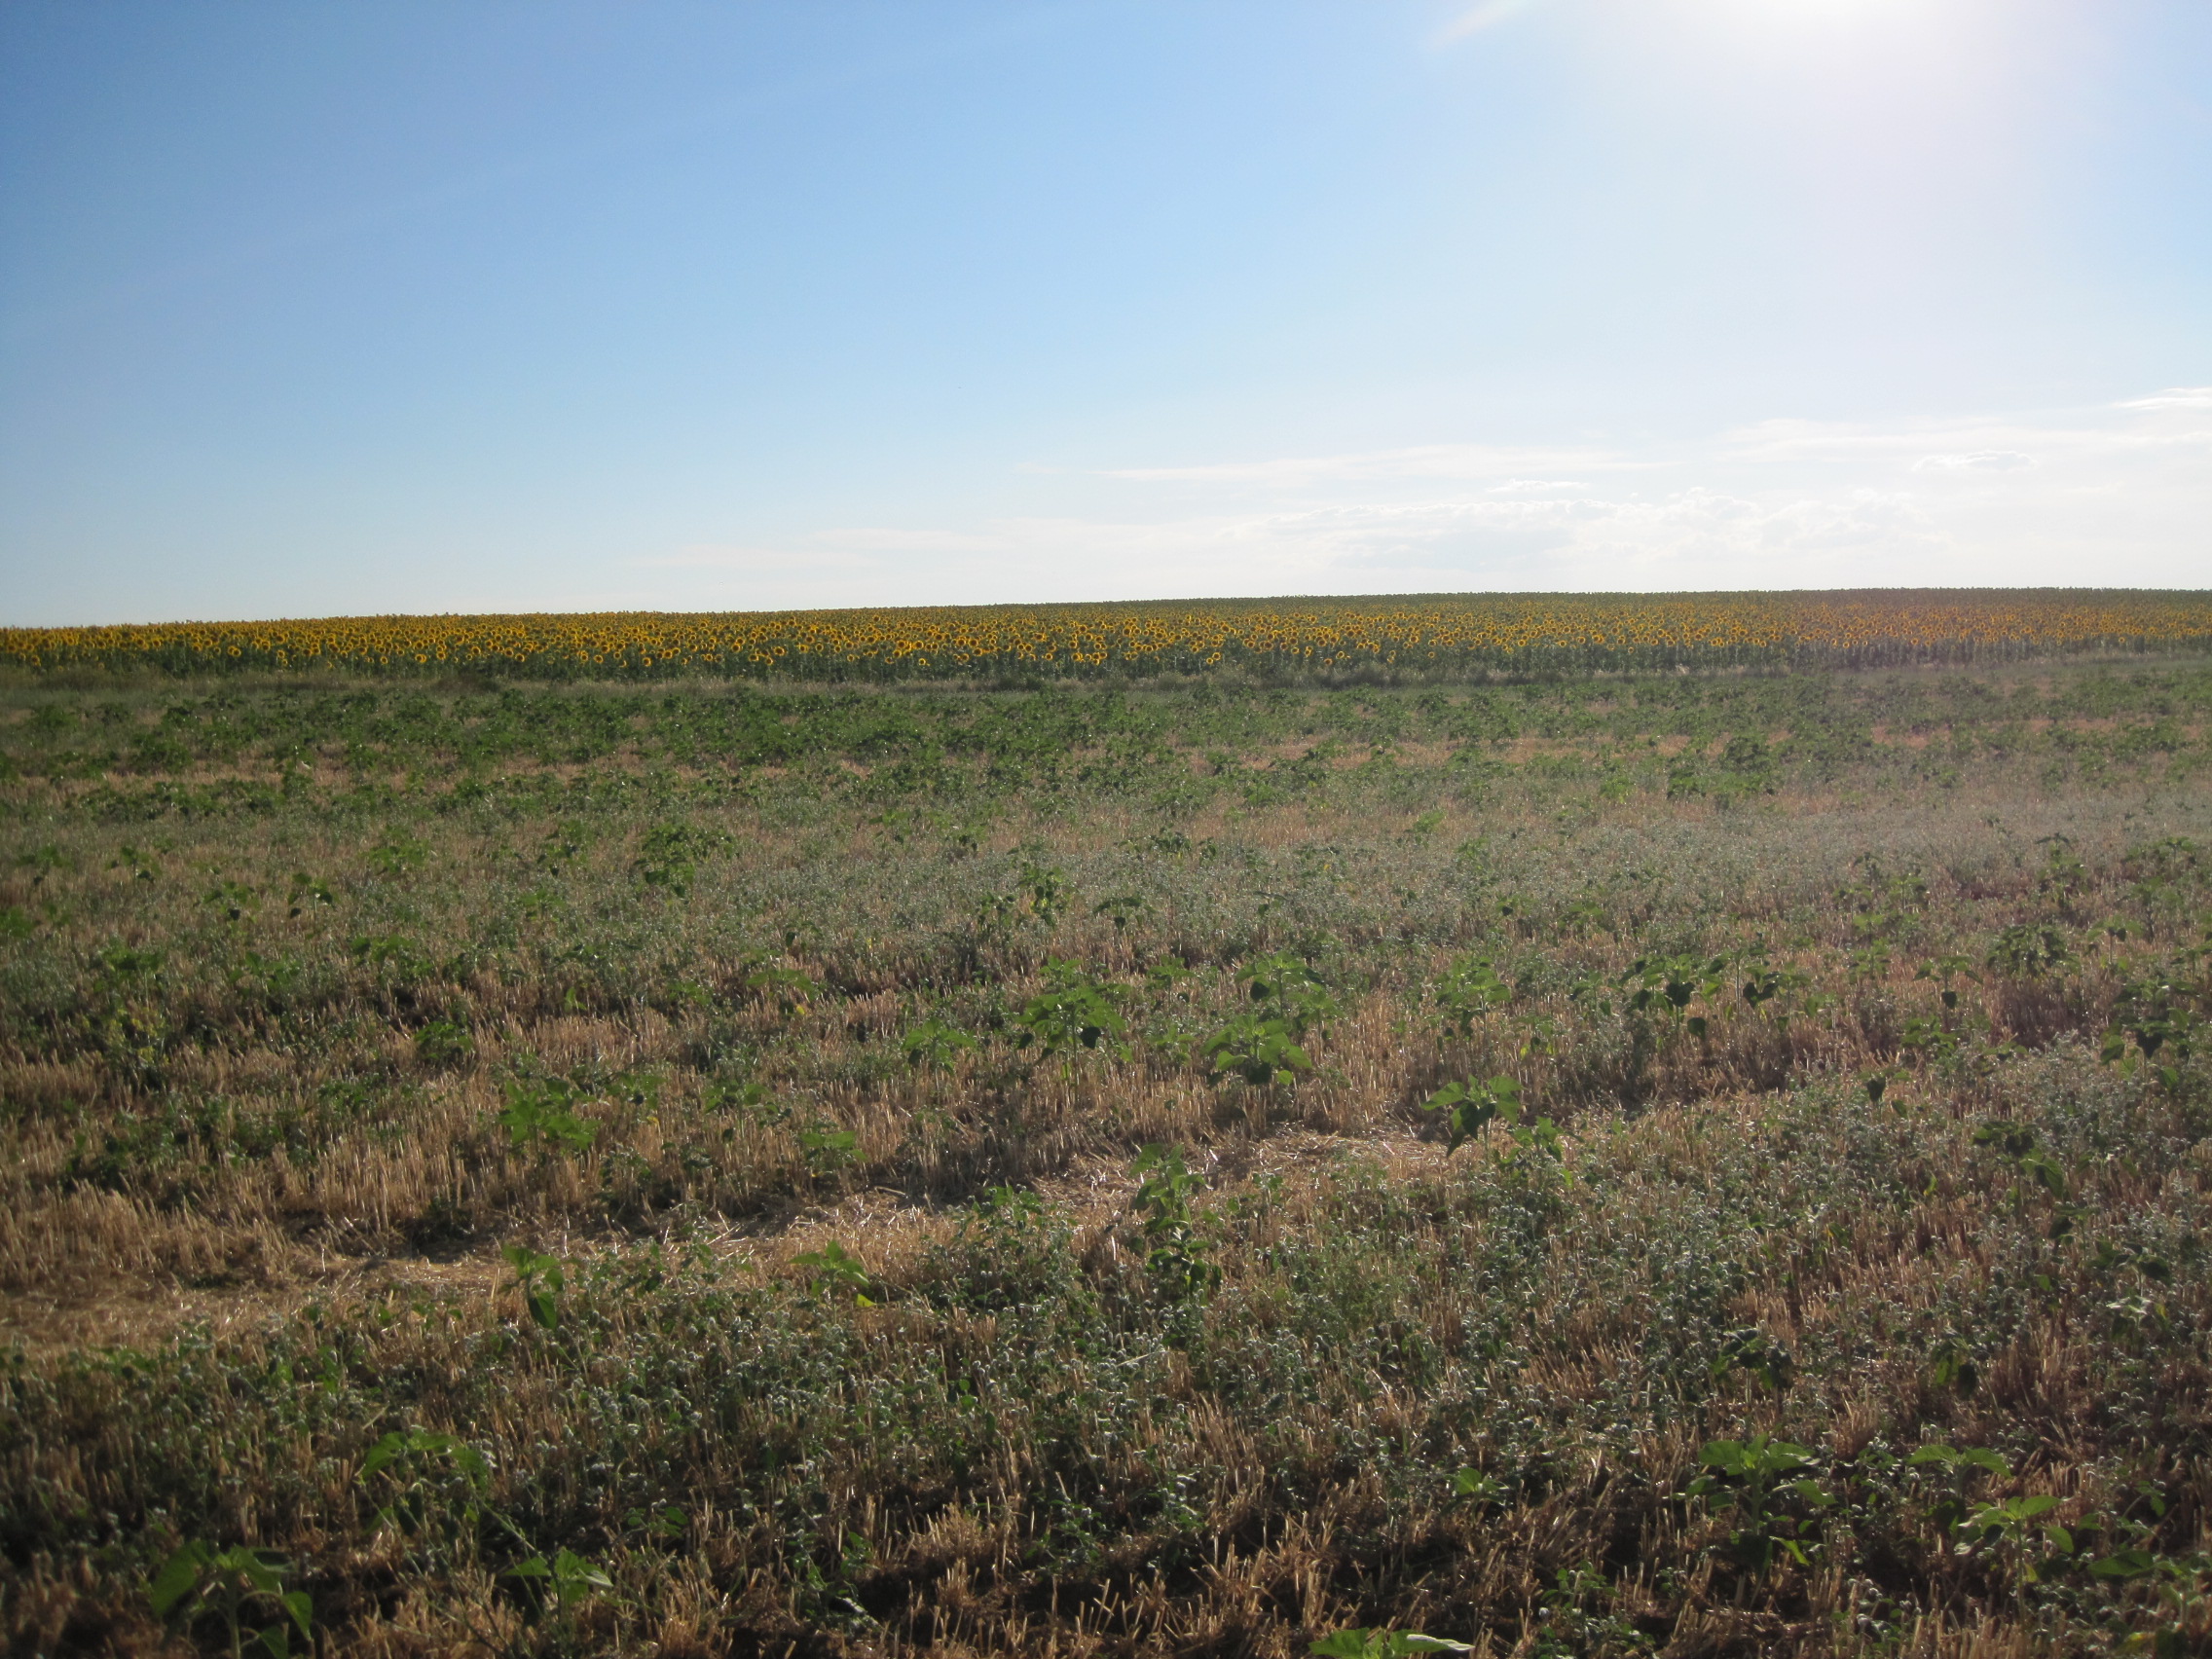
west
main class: Cropland
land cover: Barley
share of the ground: < 10 %
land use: Agriculture (excluding fallow land and kitchen gardens)
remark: Harvested field
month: July
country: ES
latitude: 42.1168
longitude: -5.2394
